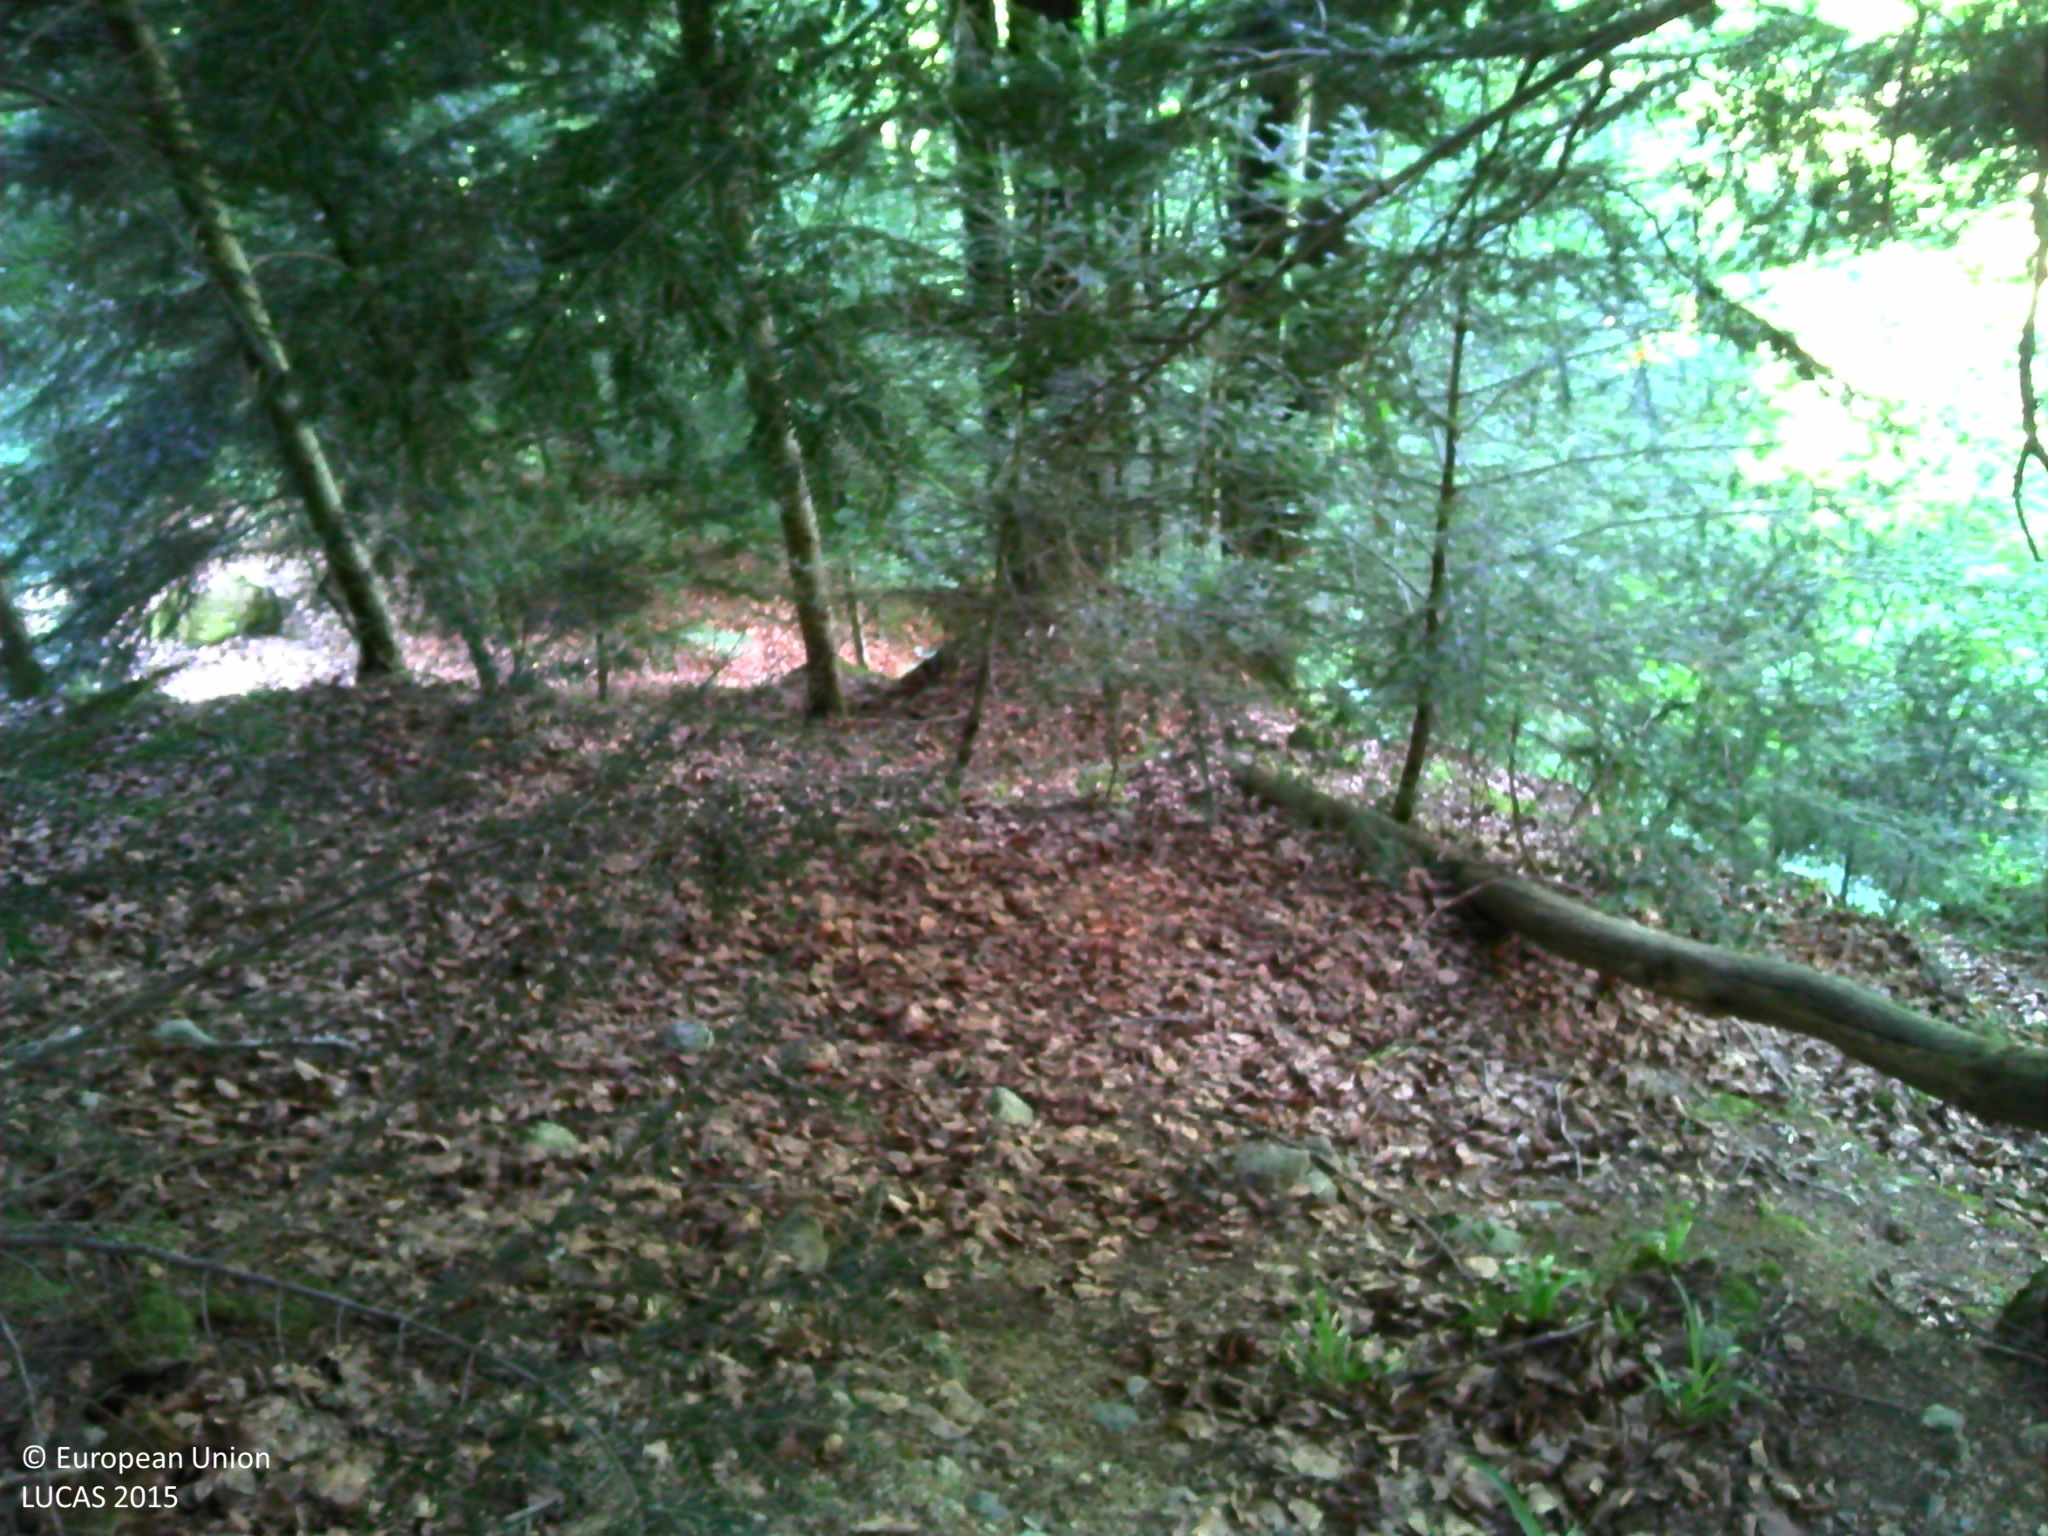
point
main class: Woodland
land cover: Other mixed woodland
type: mountainous beech forest
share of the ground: > 75 %
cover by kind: broadleaved forest trees 75 %, coniferous forest trees 25 %
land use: Forestry
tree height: > 5 m
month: July
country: FR
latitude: 42.8930
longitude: -0.1044
